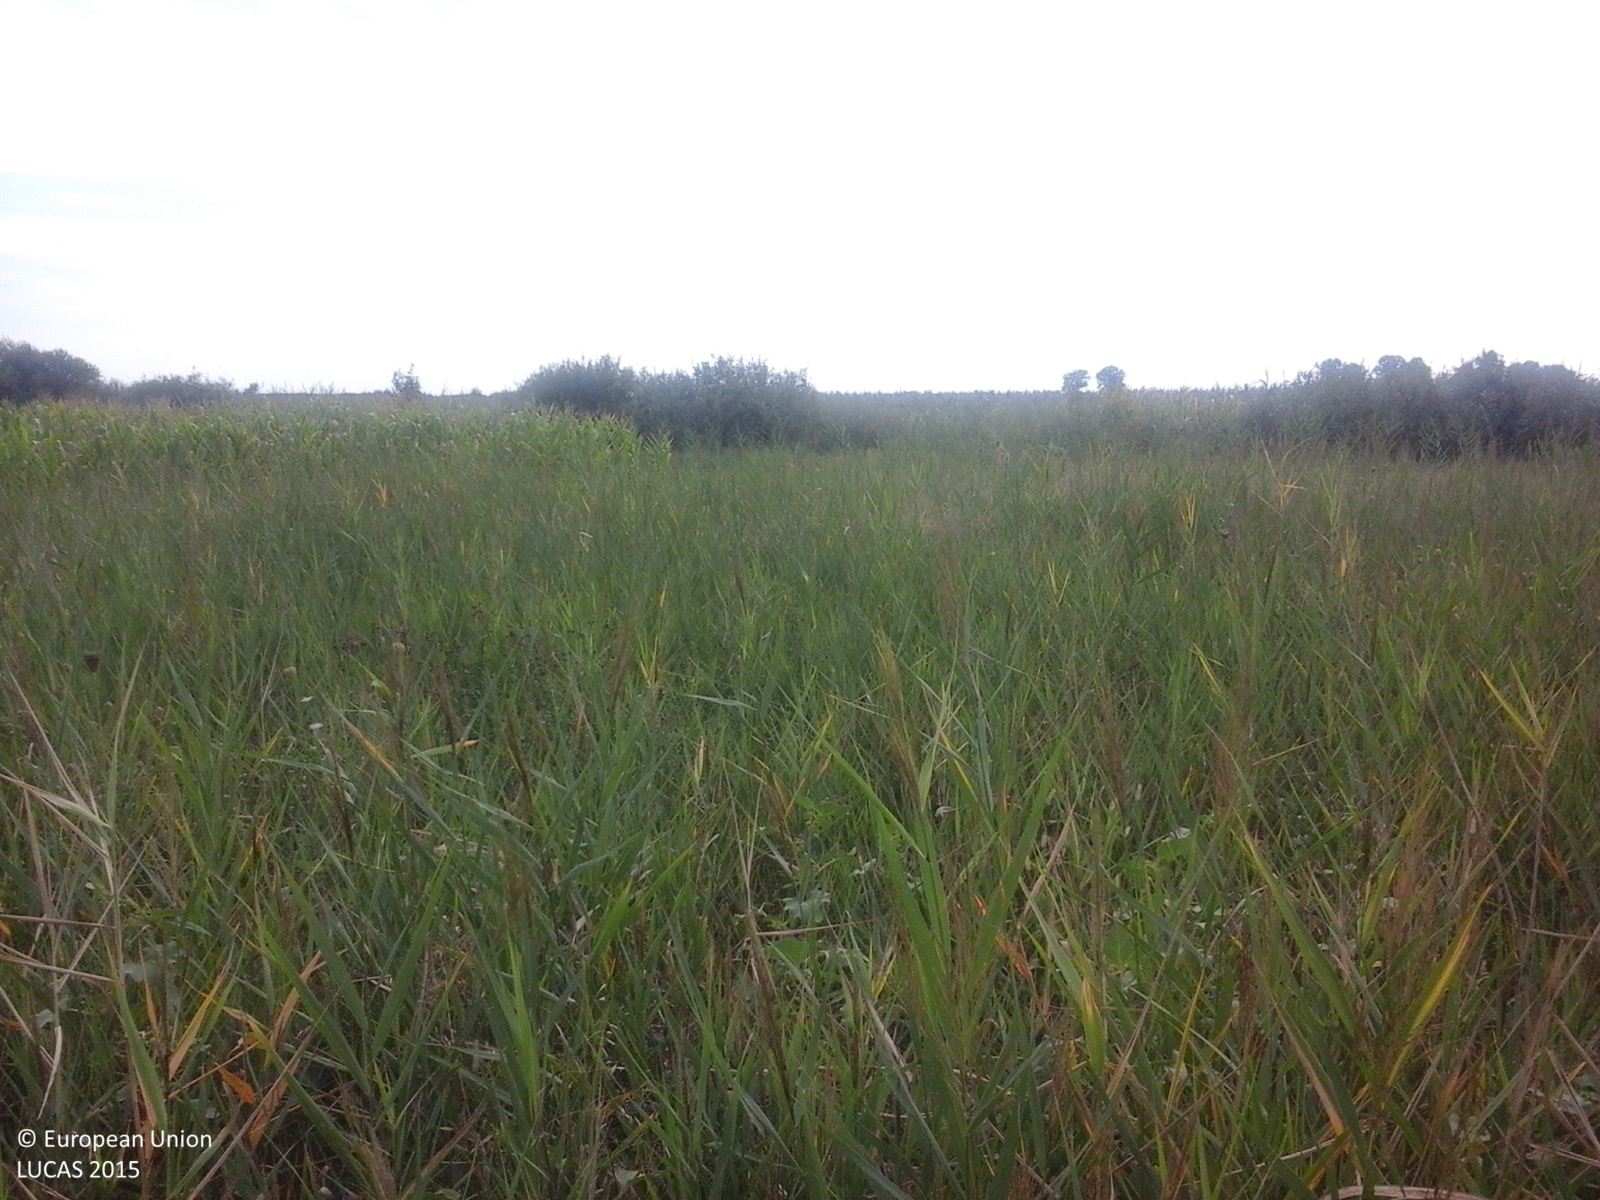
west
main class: Grassland
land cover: Spontaneously vegetated surfaces
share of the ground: > 75 %
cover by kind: herbaceous plants 100 %
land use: Agriculture (excluding fallow land and kitchen gardens)
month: August
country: RO
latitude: 46.5514
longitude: 21.7931
